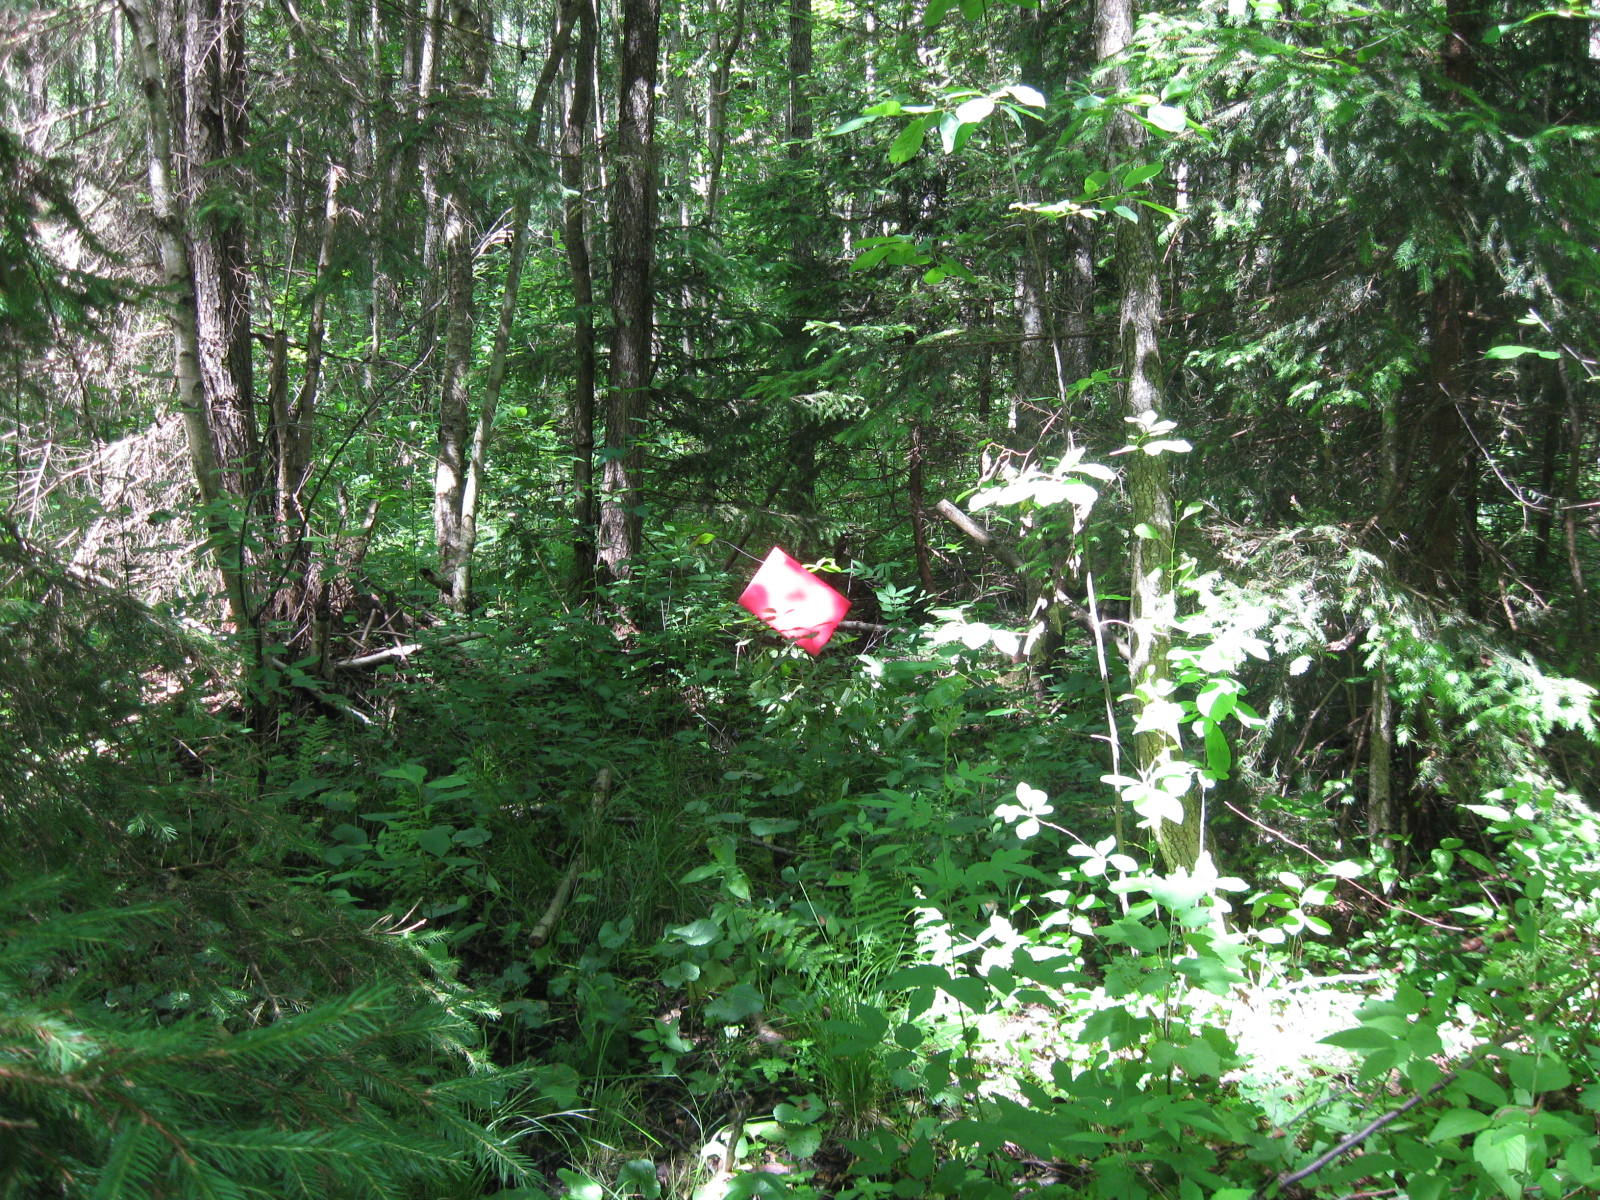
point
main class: Woodland
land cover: Spruce dominated mixed woodland
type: hemiboreal forest and nemoral coniferous forest and mixed broadleaved-coniferous forest
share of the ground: > 75 %
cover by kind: broadleaved forest trees 70 %, coniferous forest trees 30 %
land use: Forestry
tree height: > 5 m
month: June
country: LT
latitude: 53.9631
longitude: 24.2275
